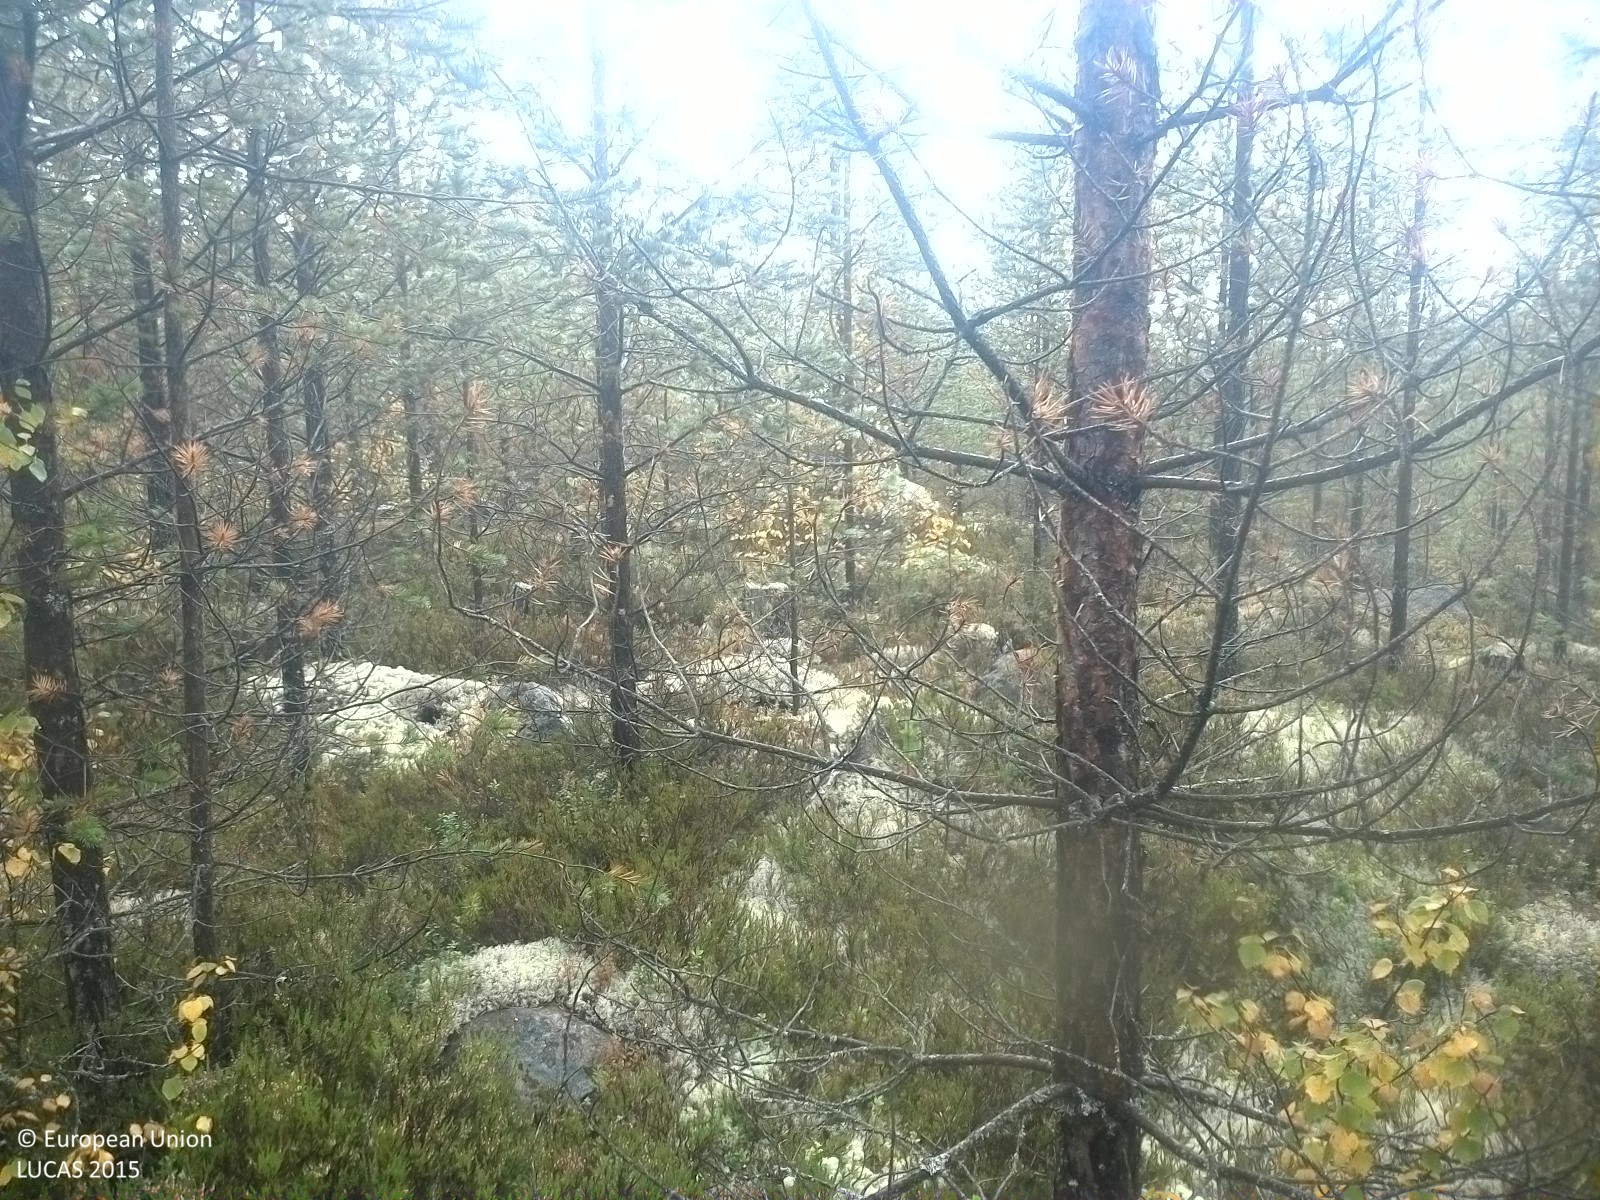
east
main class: Woodland
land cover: Pine dominated coniferous woodland
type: boreal forest
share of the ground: 25 - 50 %
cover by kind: shrubs 40 %, coniferous forest trees 35 %, lichens and mosses 20 %, broadleaved forest trees 5 %
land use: Forestry
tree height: > 5 m
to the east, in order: Pine dominated coniferous woodland; Other mixed woodland; Broadleaved woodland
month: September
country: SE
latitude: 62.1466
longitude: 15.6027
